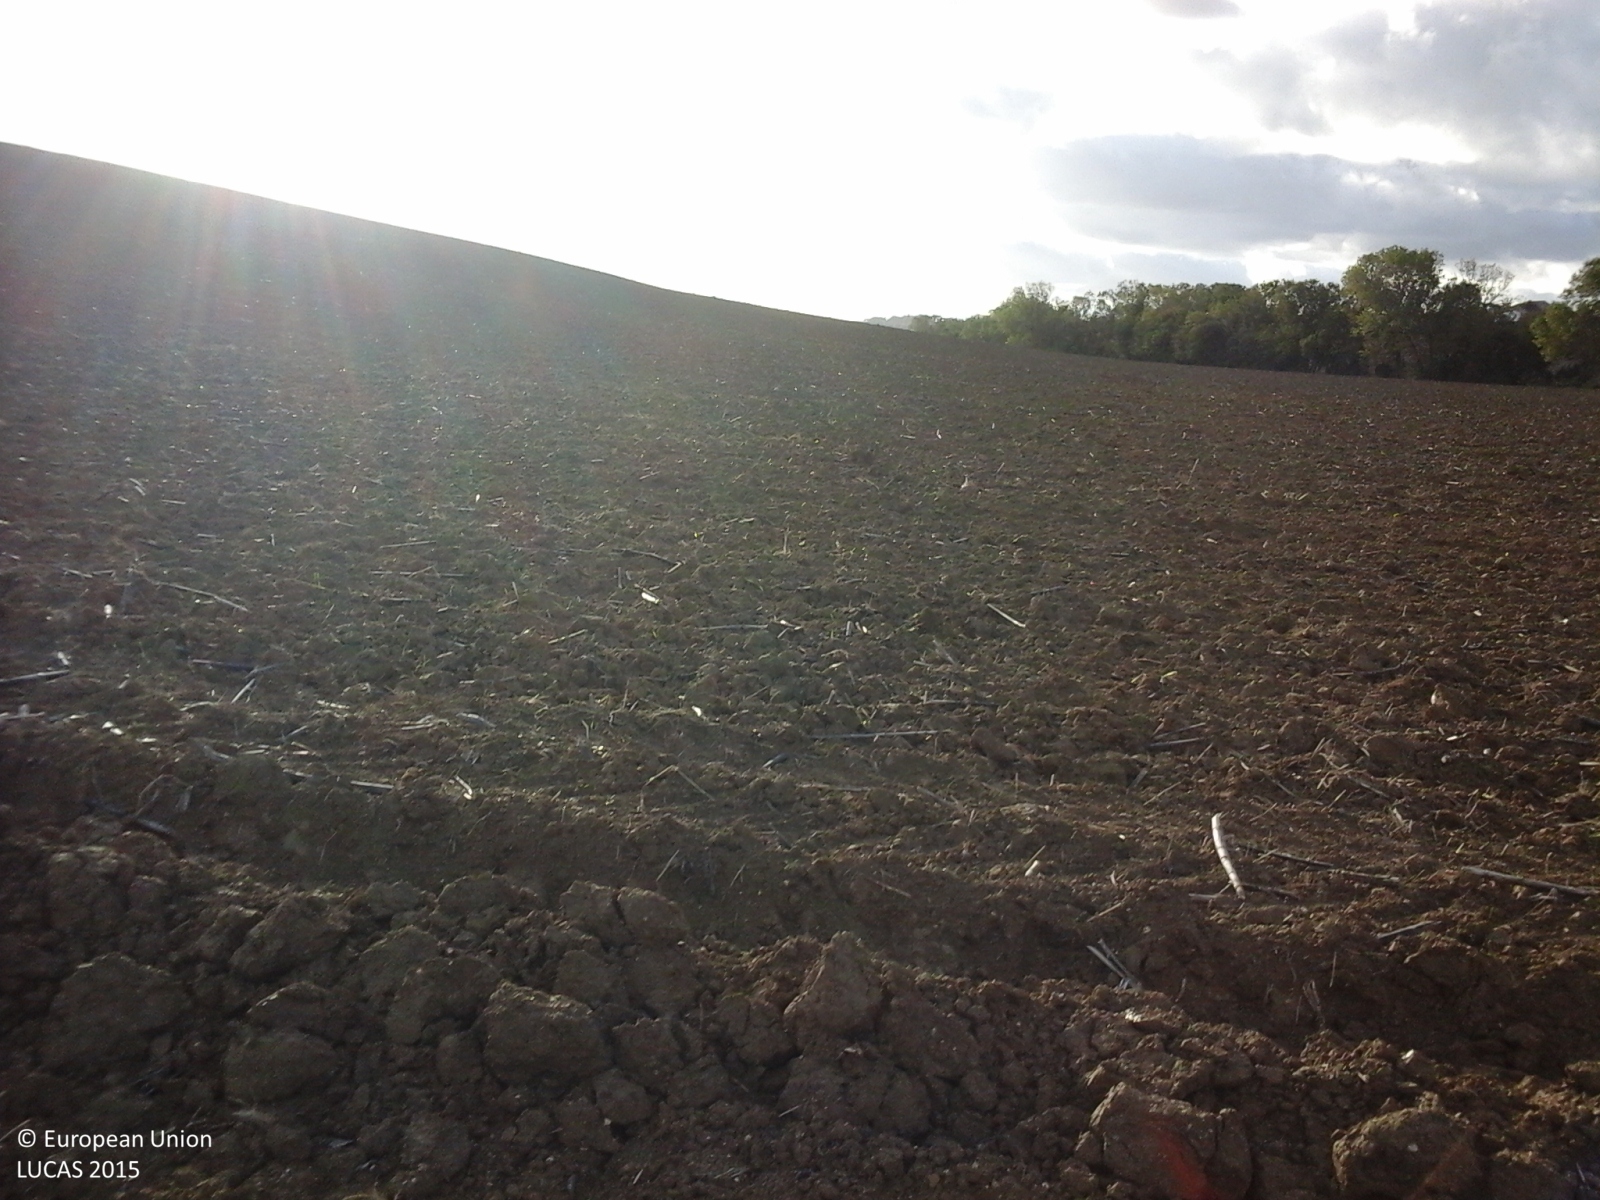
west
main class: Cropland
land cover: Sunflower
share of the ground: < 10 %
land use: Agriculture (excluding fallow land and kitchen gardens)
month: October
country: IT
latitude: 43.6677
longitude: 13.2540
